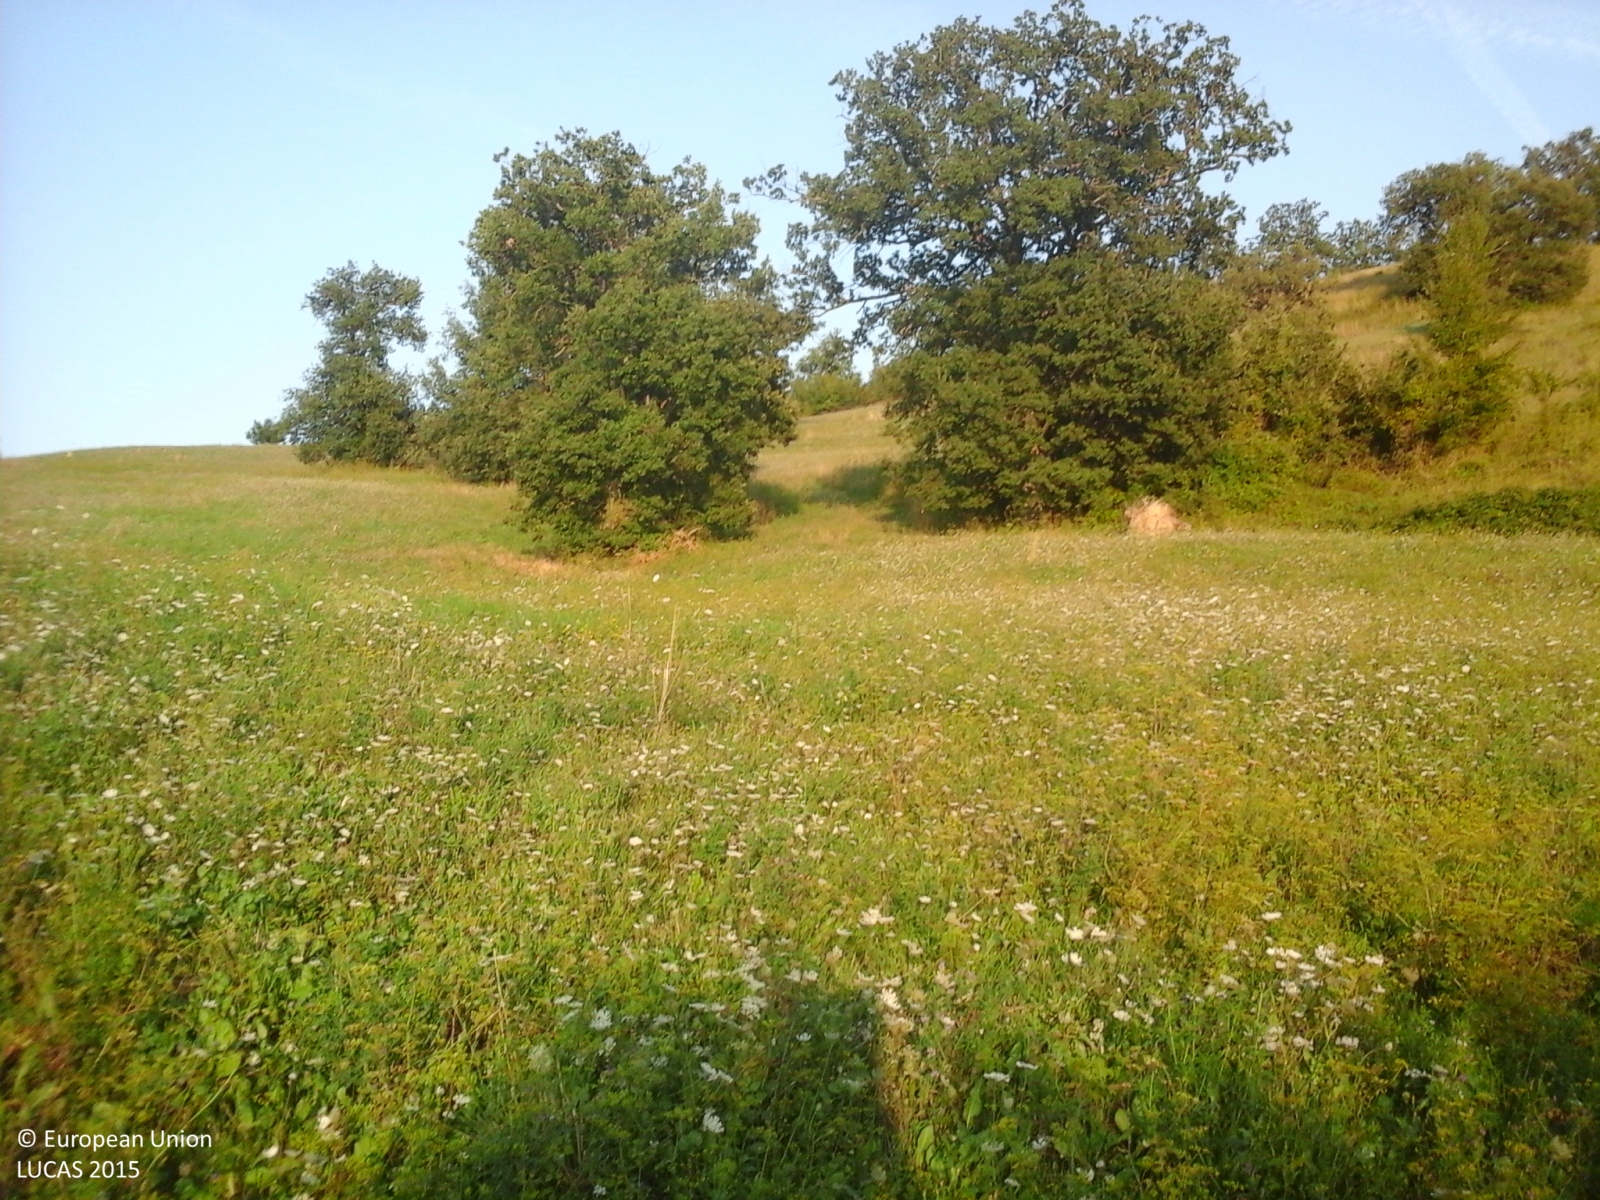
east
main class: Grassland
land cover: Grassland without tree/shrub cover
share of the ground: > 75 %
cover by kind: herbaceous plants 100 %
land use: Semi-natural and natural areas not in use
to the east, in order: Grassland without tree/shrub cover; Broadleaved woodland; Grassland without tree/shrub cover; Broadleaved woodland; Grassland without tree/shrub cover; Shrubland with sparse tree cover; Grassland without tree/shrub cover
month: August
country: IT
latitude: 42.9769
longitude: 13.3872
